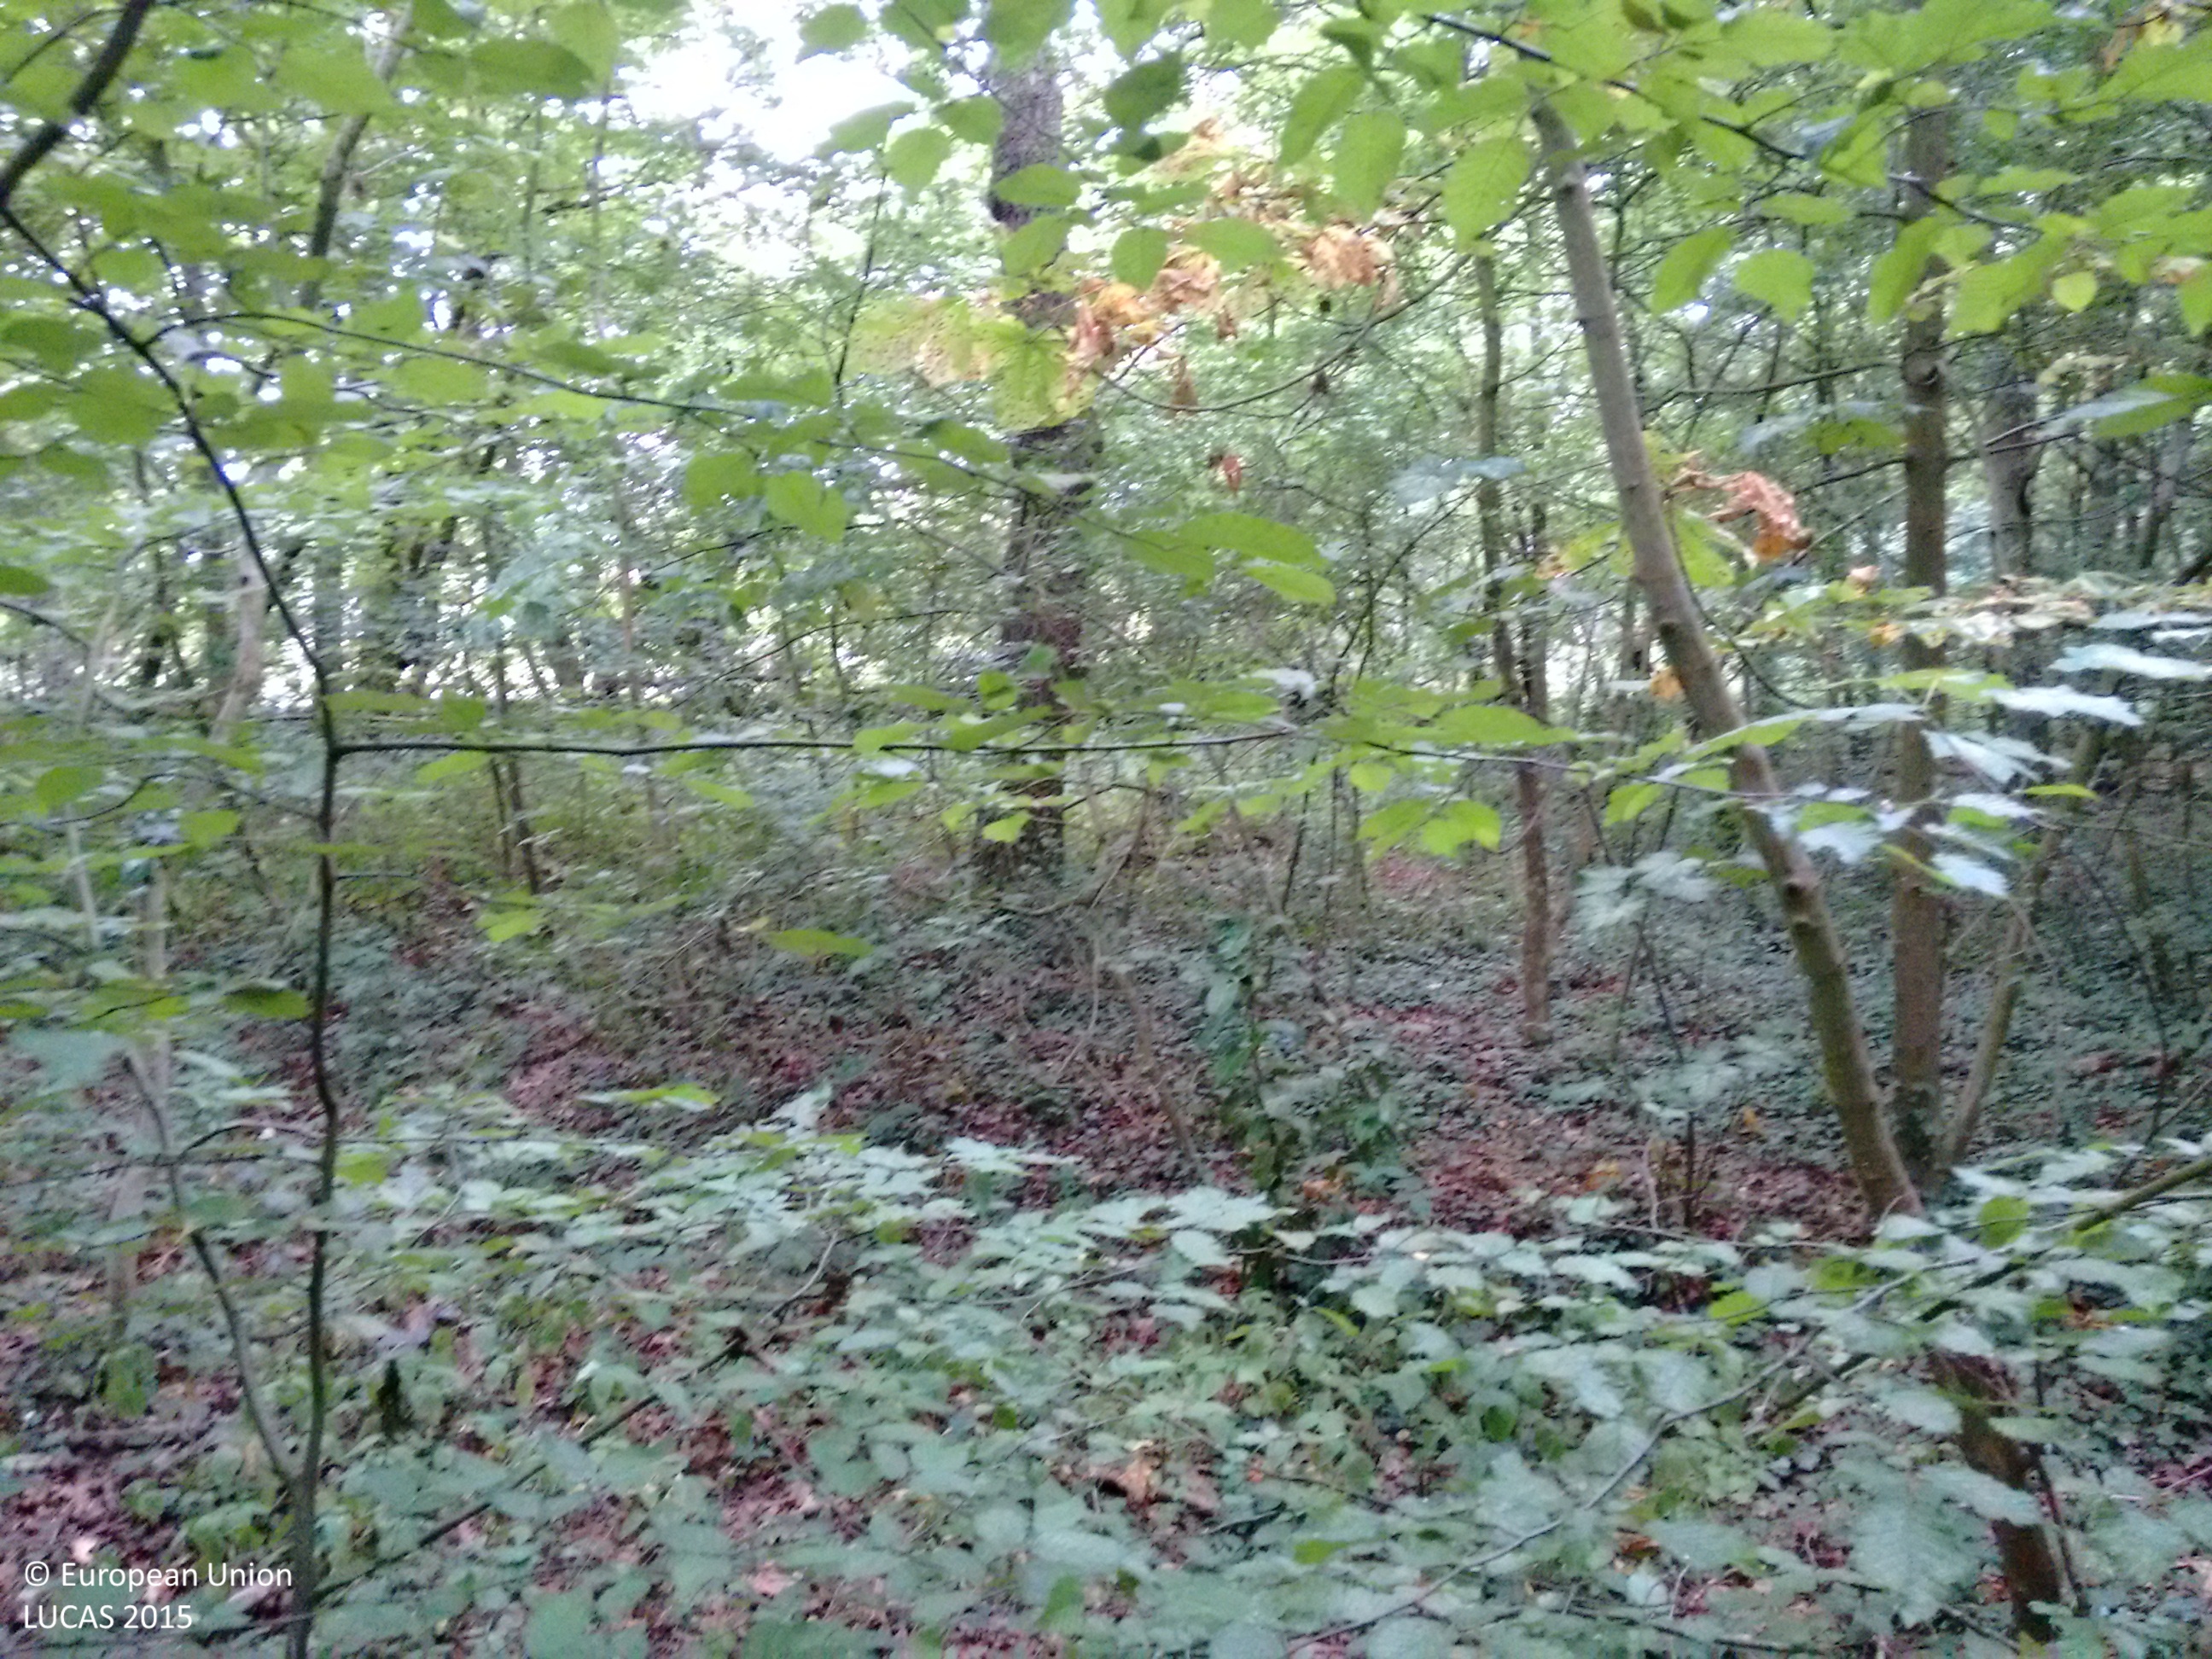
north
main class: Woodland
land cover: Broadleaved woodland
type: mesophytic deciduous forest
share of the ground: > 75 %
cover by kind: broadleaved forest trees 80 %, shrubs 15 %, herbaceous plants 5 %
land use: Amenities, museums, leisure
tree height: > 5 m
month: July
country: GB
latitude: 51.3124
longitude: -0.2938
